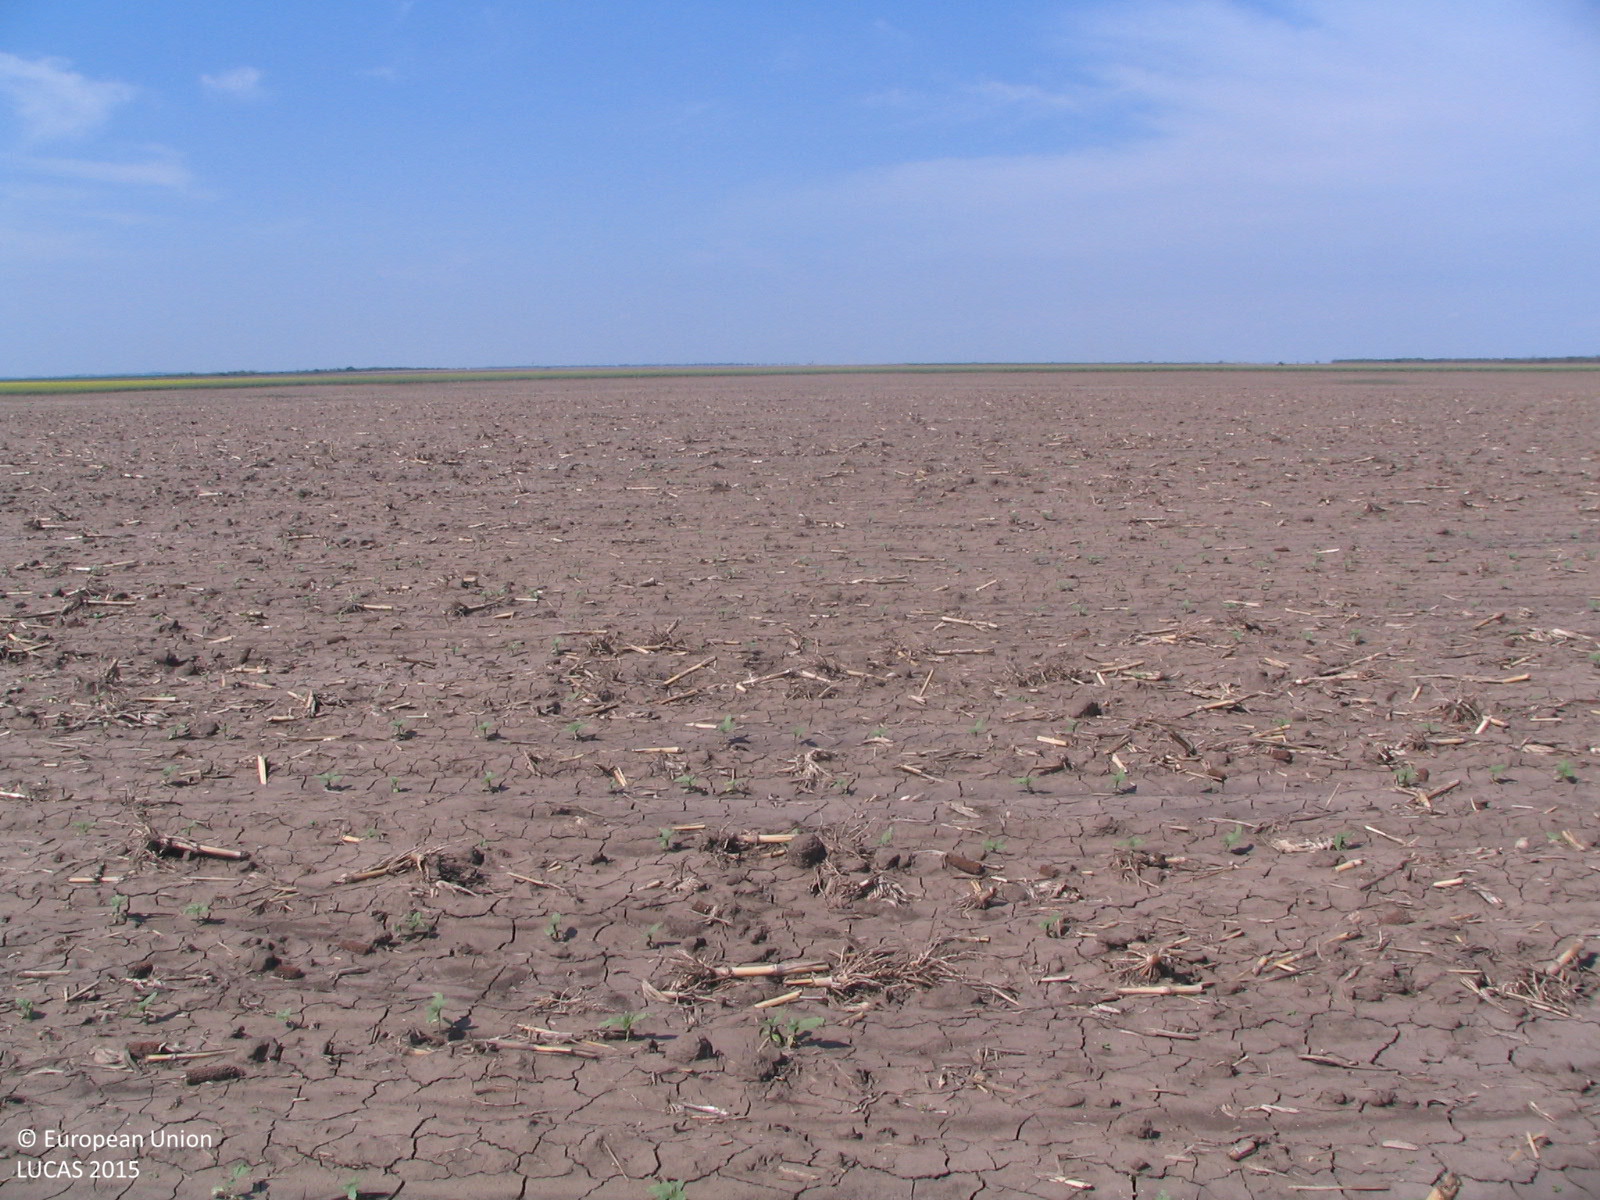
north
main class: Cropland
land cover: Sunflower
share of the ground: < 10 %
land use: Agriculture (excluding fallow land and kitchen gardens)
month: May
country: BG
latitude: 43.5776
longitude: 24.0097
